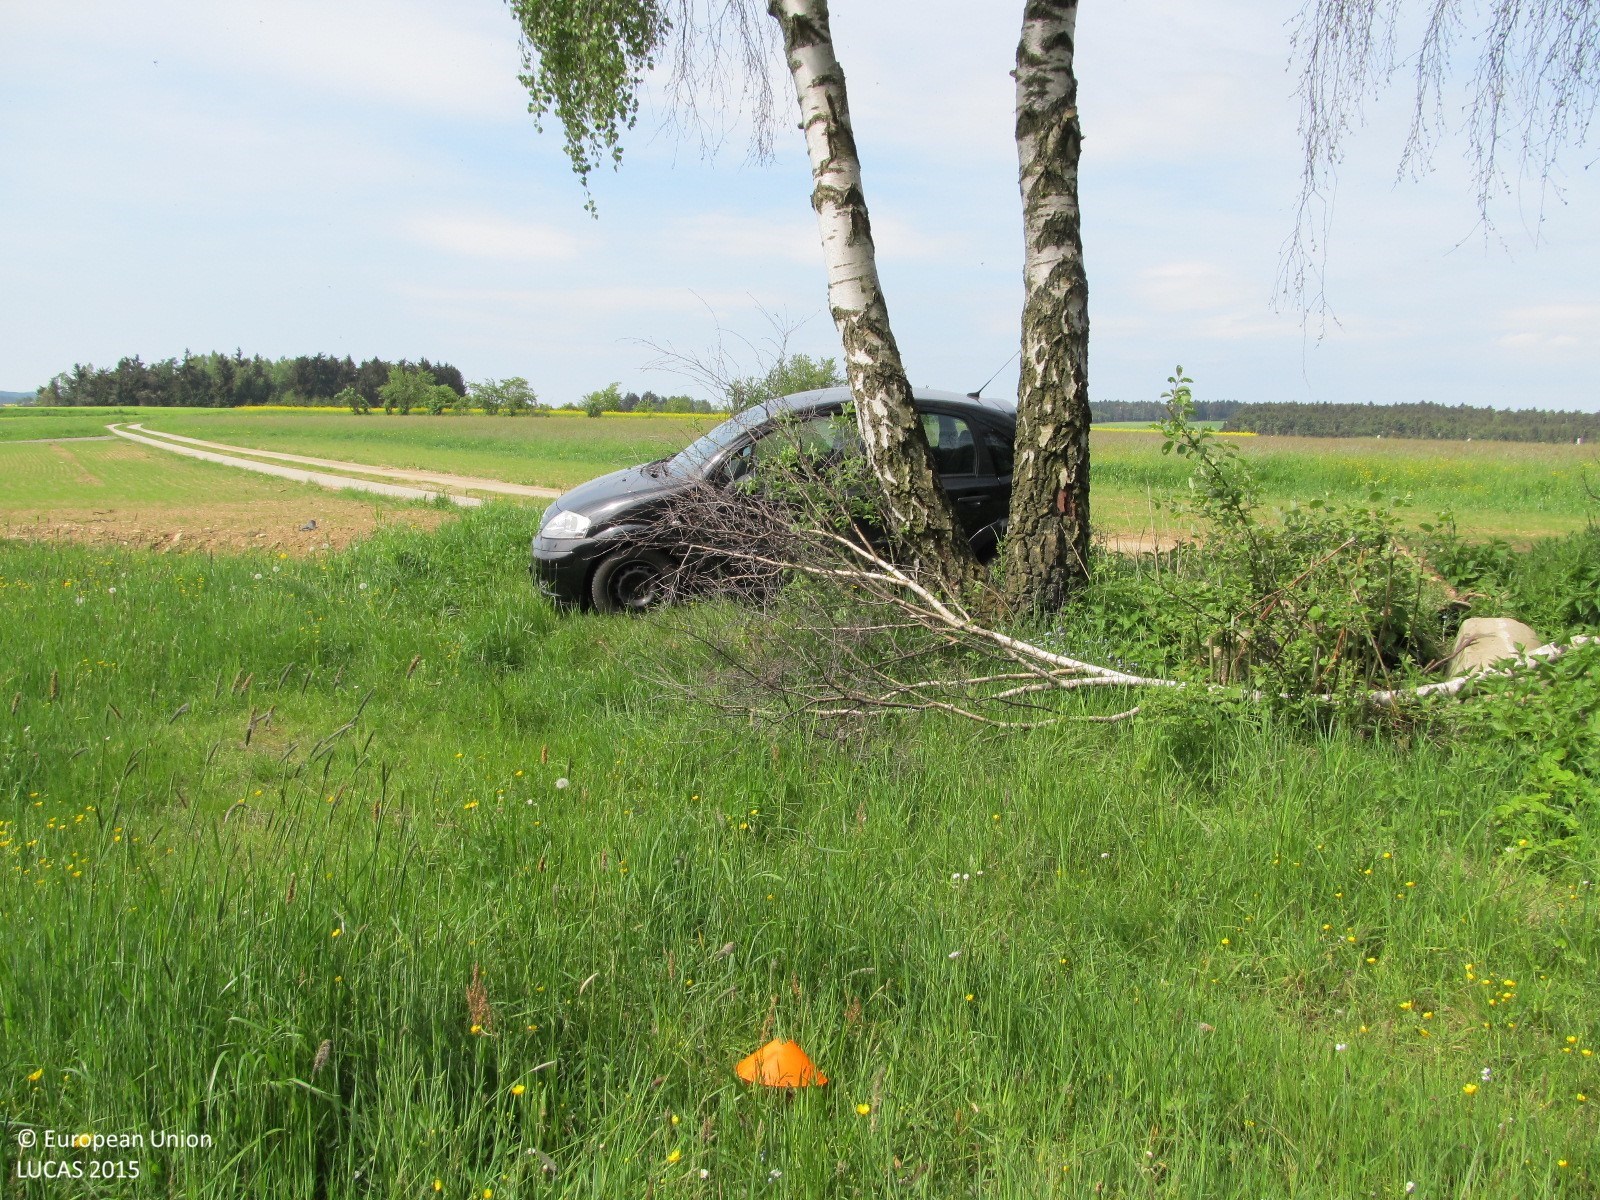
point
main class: Grassland
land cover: Grassland without tree/shrub cover
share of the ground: > 75 %
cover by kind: herbaceous plants 100 %
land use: Agriculture (excluding fallow land and kitchen gardens)
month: May
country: AT
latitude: 48.4918
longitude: 15.3202
